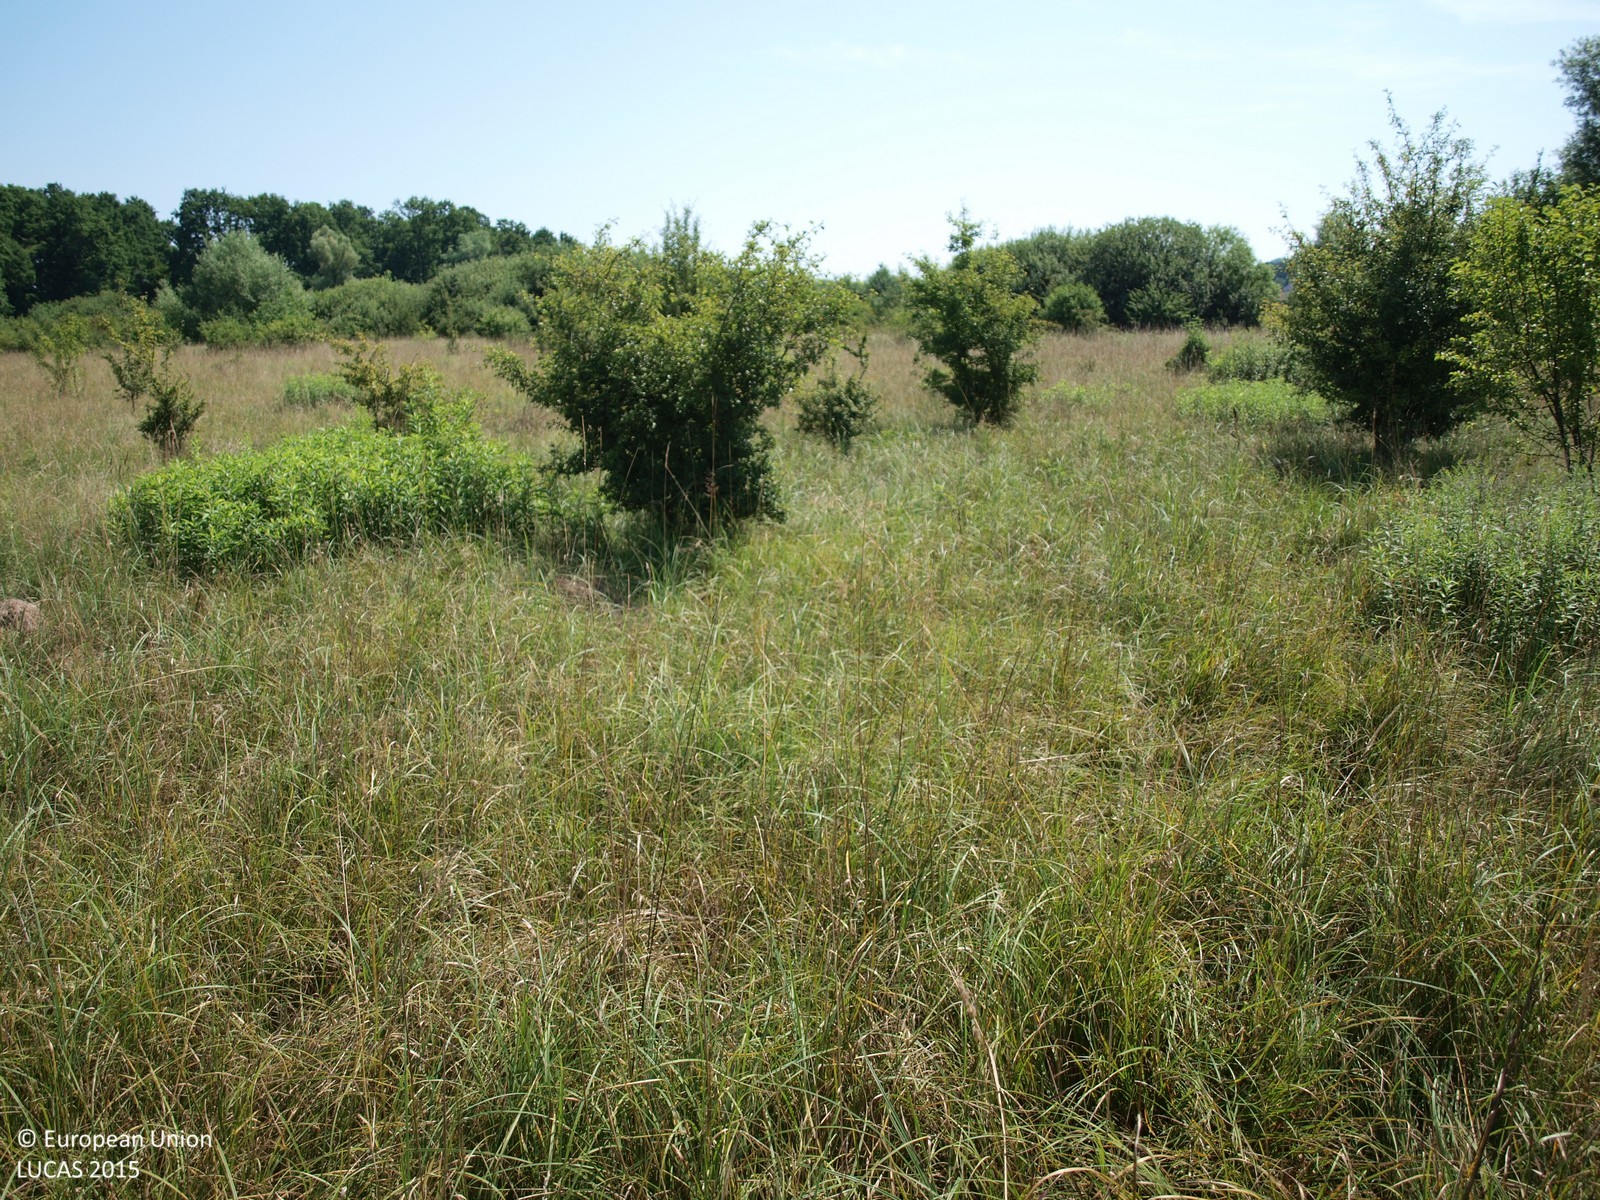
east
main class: Grassland
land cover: Grassland with sparse tree/shrub cover
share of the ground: > 75 %
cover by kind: herbaceous plants 95 %, broadleaved forest trees 5 %
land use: Abandoned areas
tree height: < 5 m
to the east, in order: Grassland with sparse tree/shrub cover; Maize; Grassland without tree/shrub cover
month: July
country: HR
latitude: 46.0063
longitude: 15.9258
